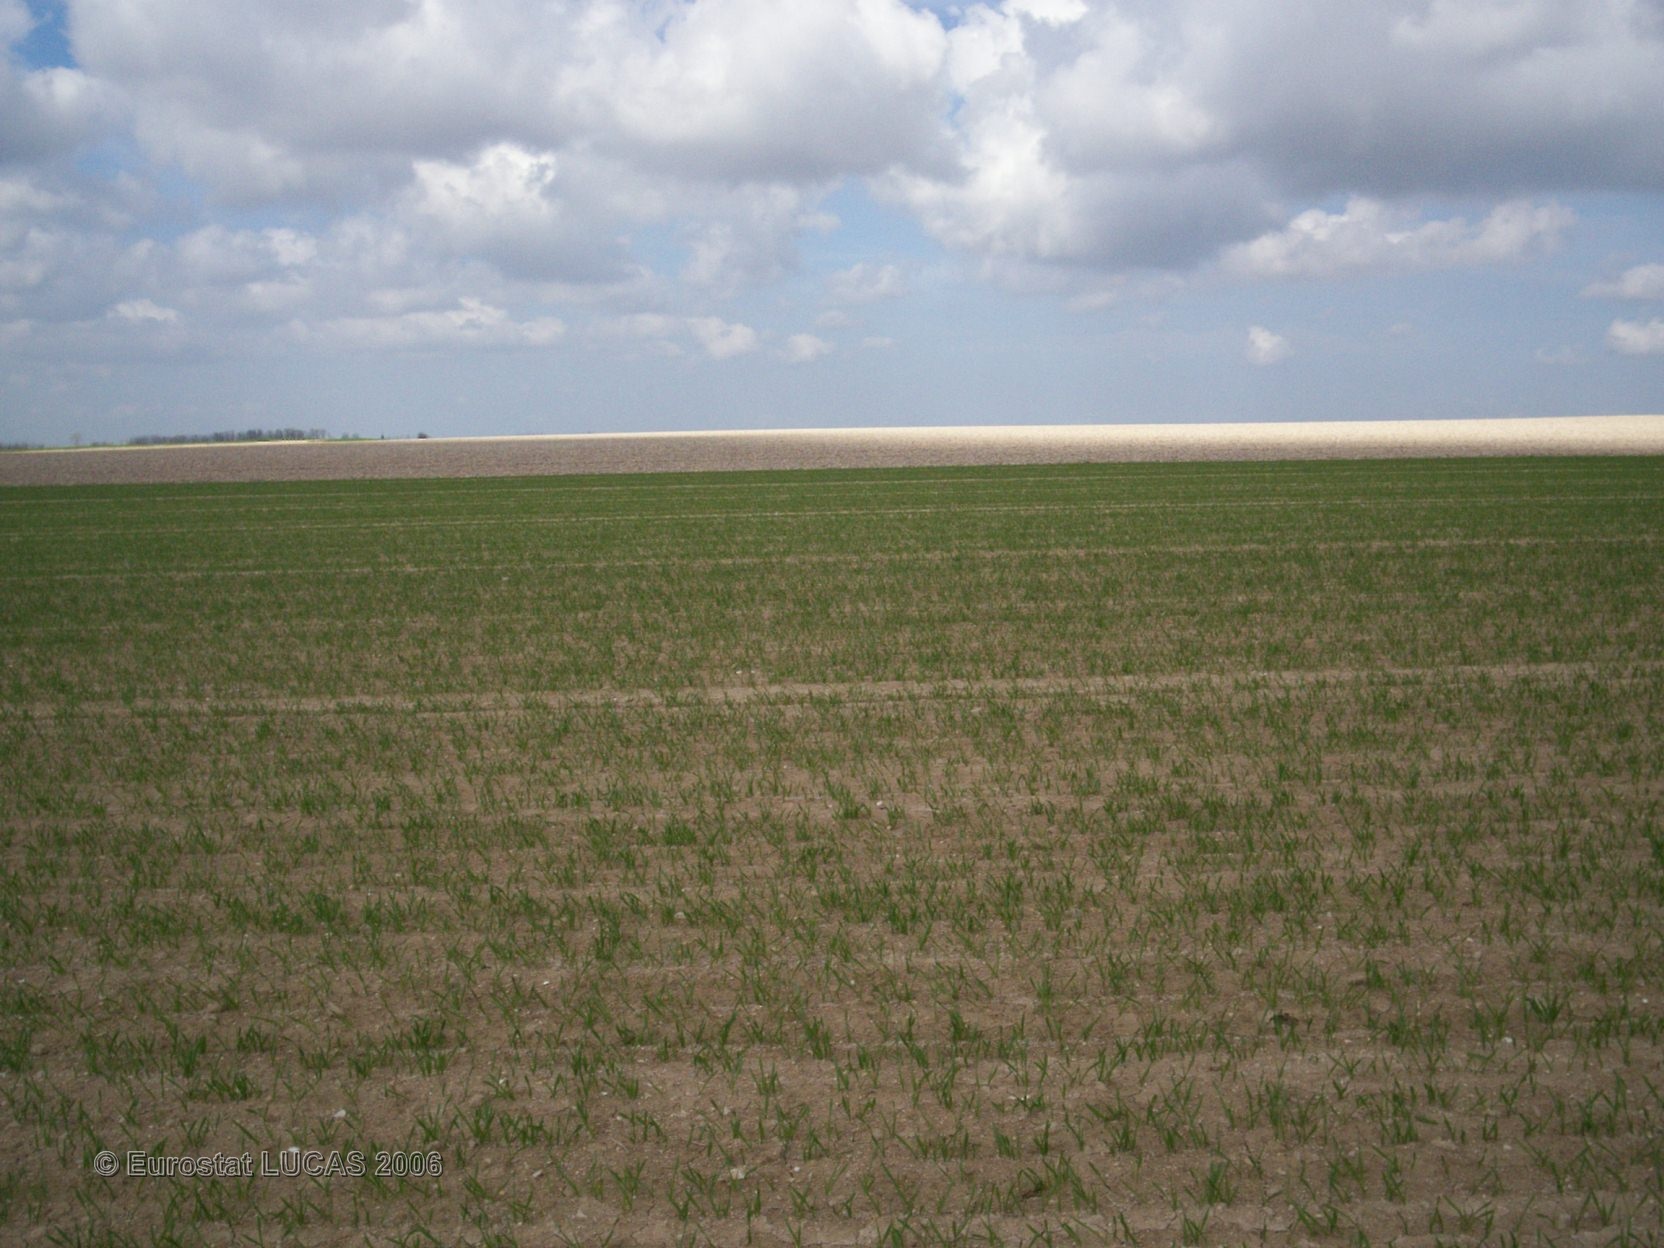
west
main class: Cropland
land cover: Barley
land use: Agriculture (excluding fallow land and kitchen gardens)
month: April
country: FR
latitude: 48.5799
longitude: 3.9363
